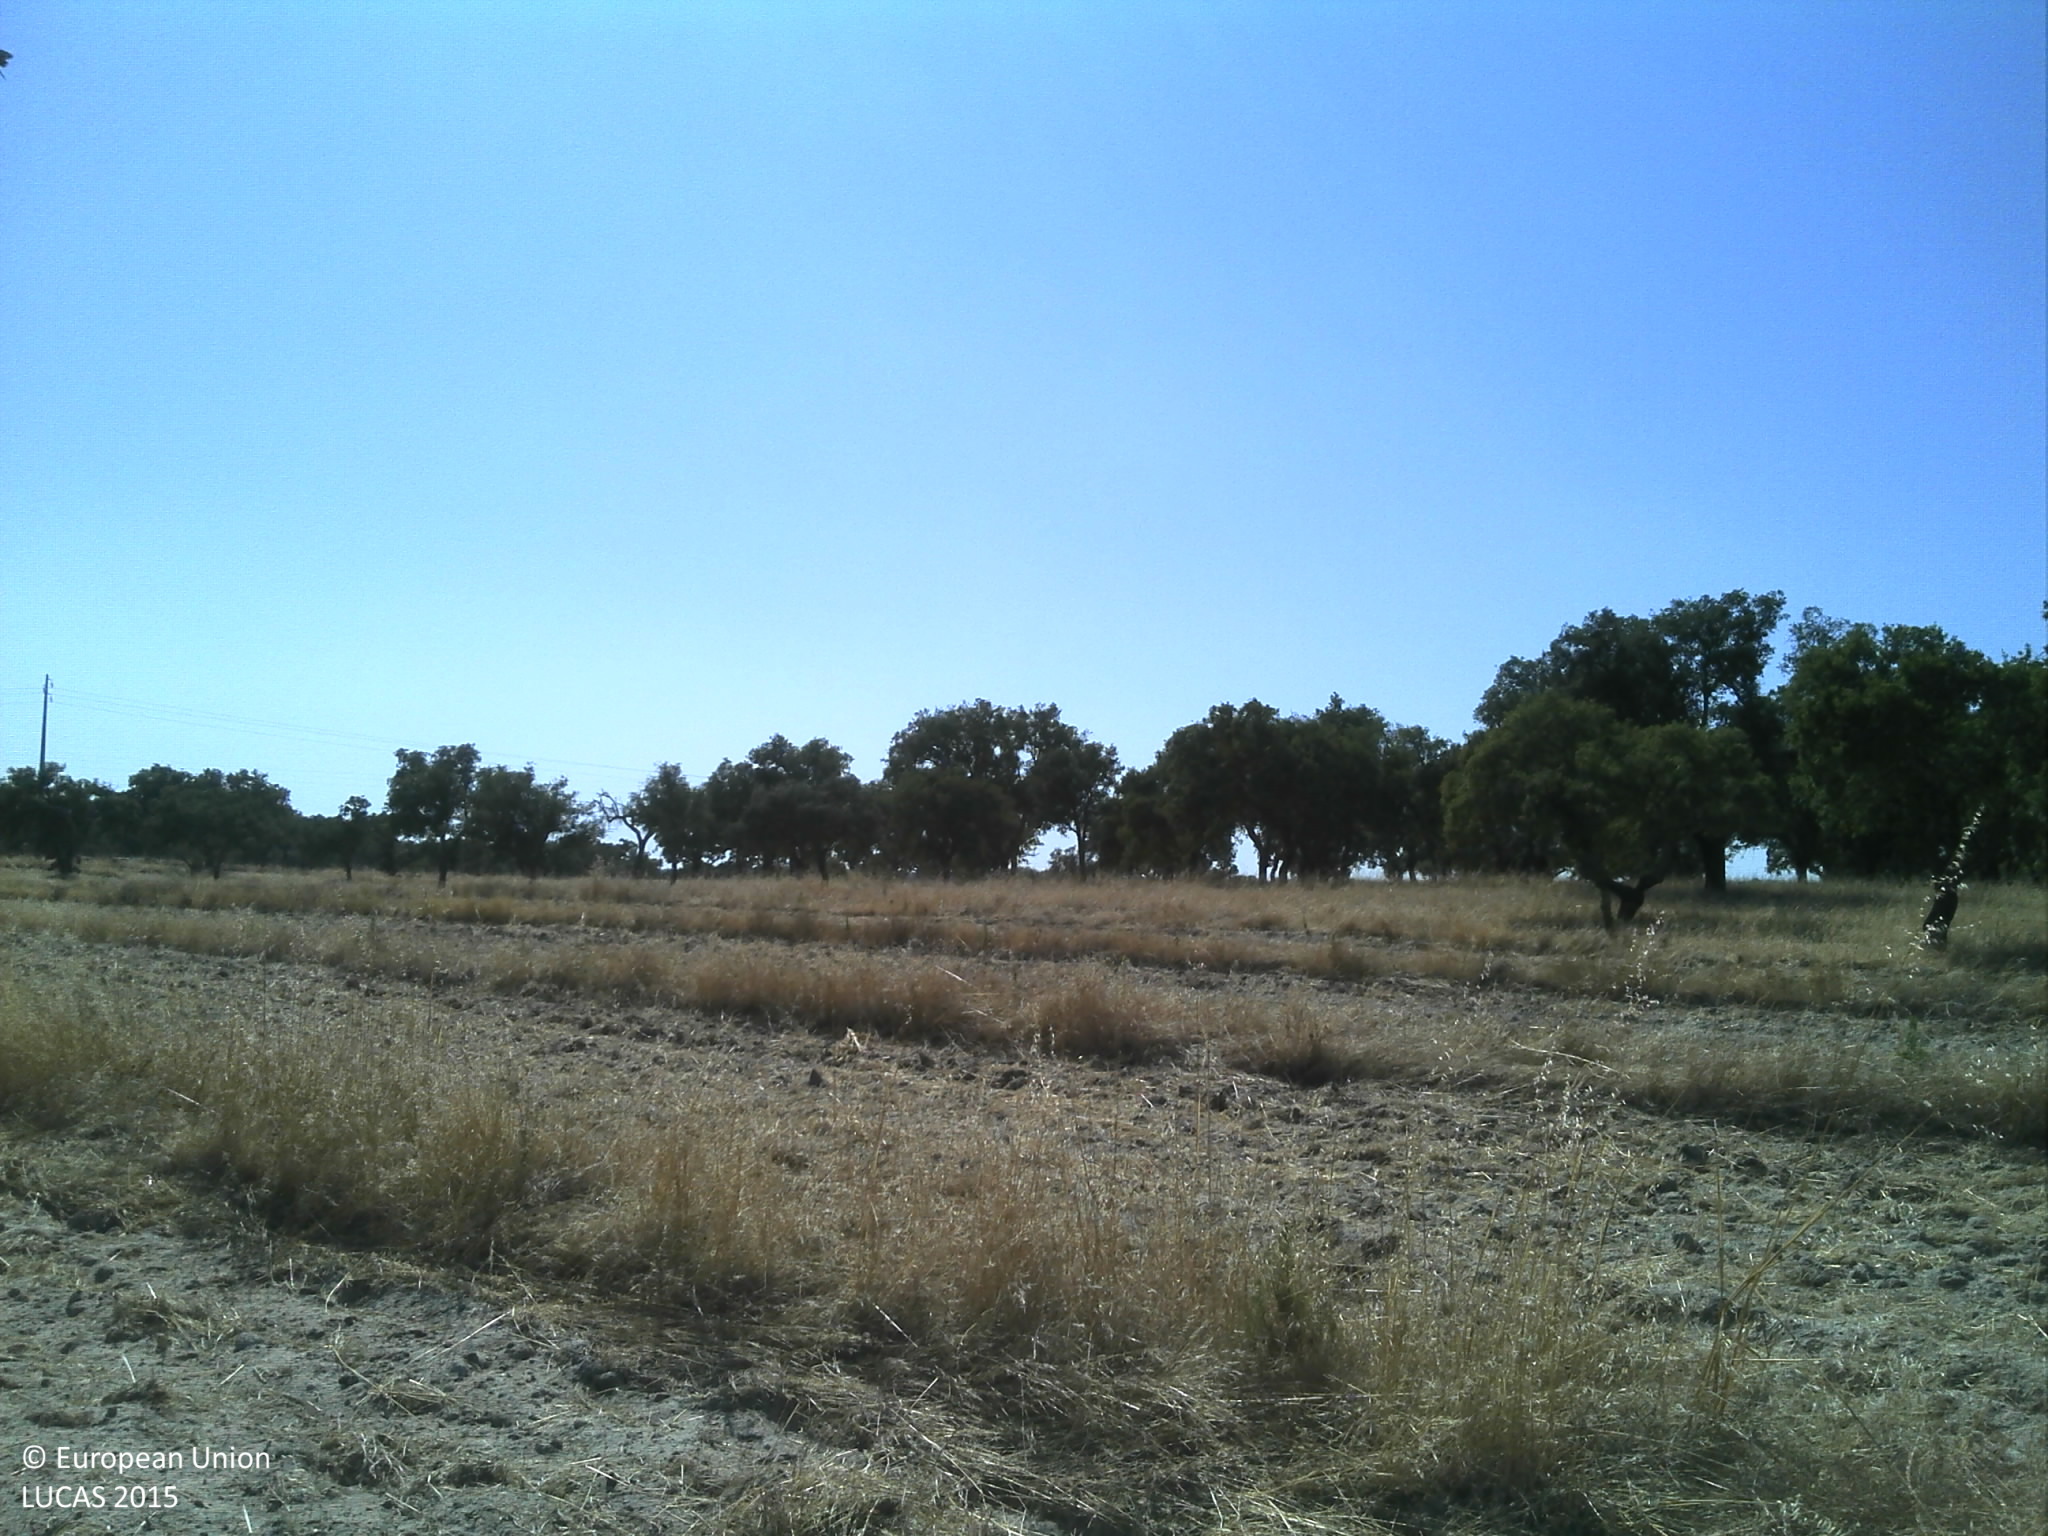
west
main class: Grassland
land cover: Grassland with sparse tree/shrub cover
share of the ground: 10 - 25 %
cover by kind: unconsolidated bare surface 80 %, herbaceous plants 15 %, broadleaved forest trees 5 %
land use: Forestry
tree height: < 5 m
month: July
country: PT
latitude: 39.3190
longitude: -7.6426
